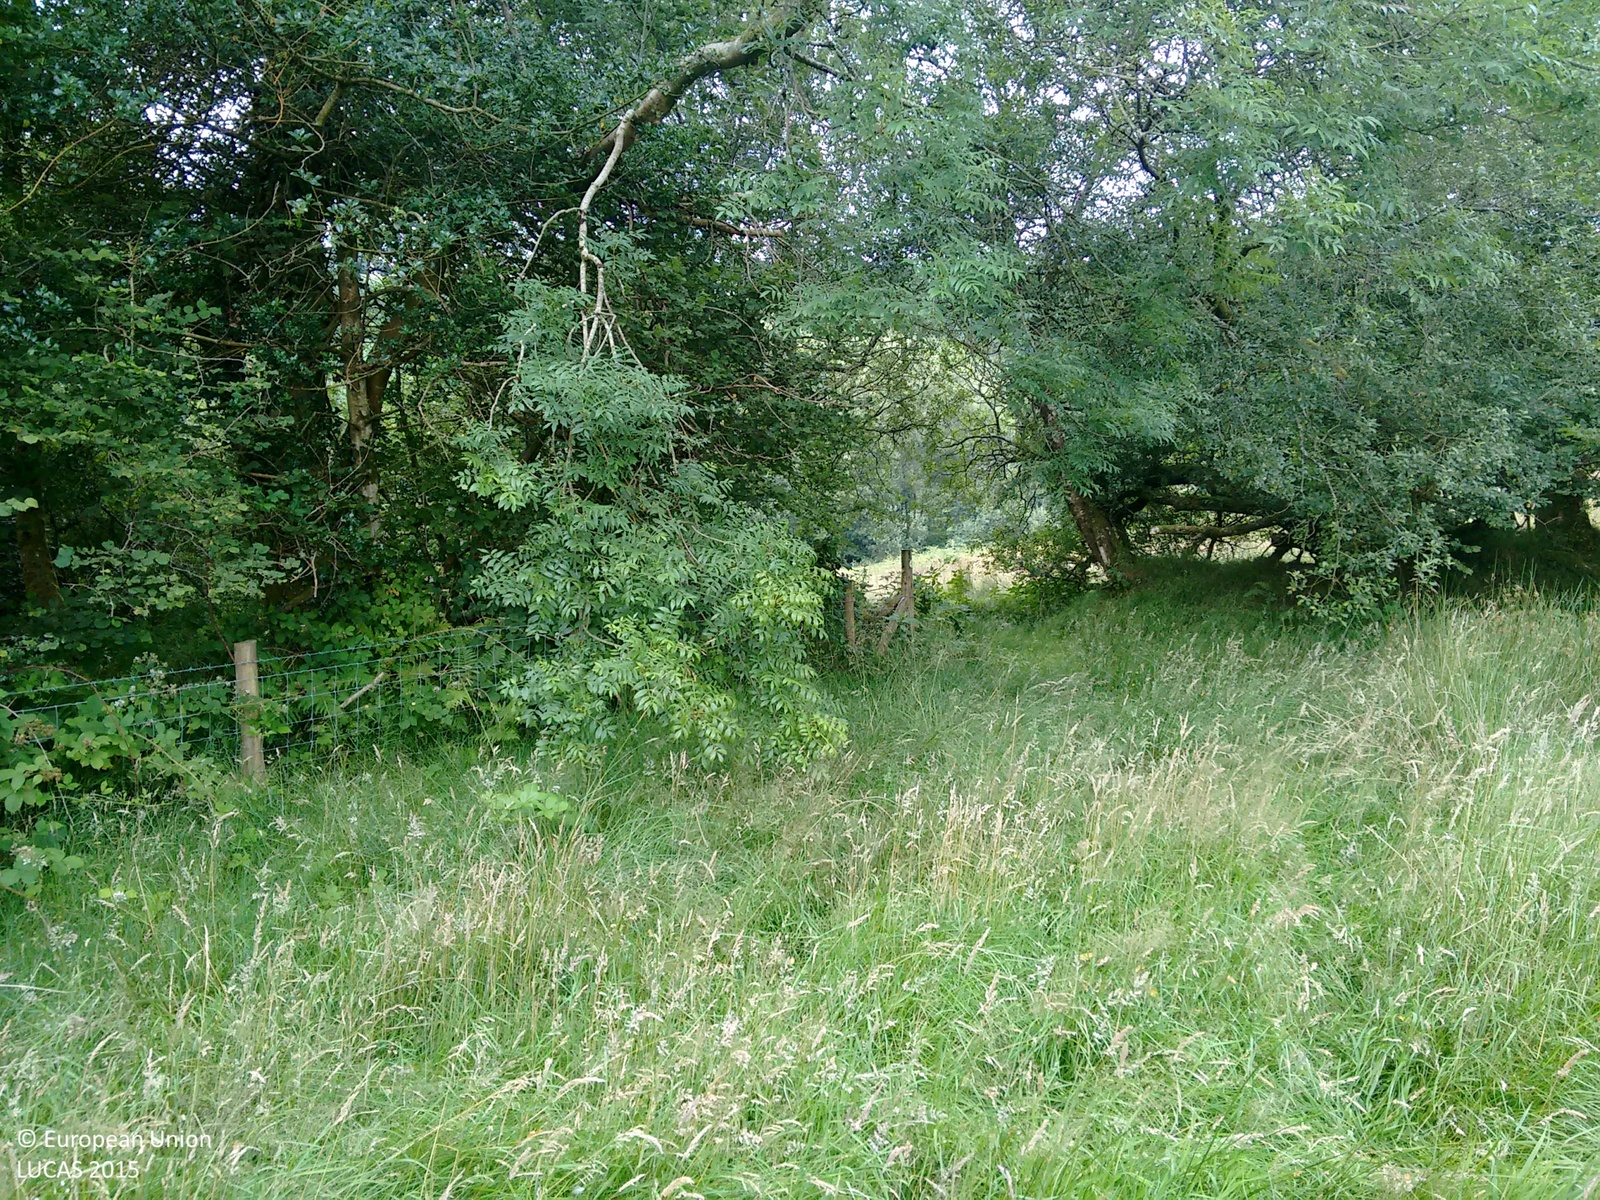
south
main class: Grassland
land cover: Grassland without tree/shrub cover
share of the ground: > 75 %
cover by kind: herbaceous plants 100 %
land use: Agriculture (excluding fallow land and kitchen gardens)
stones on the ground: < 10 %
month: August
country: GB
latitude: 52.0085
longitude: -3.9185
